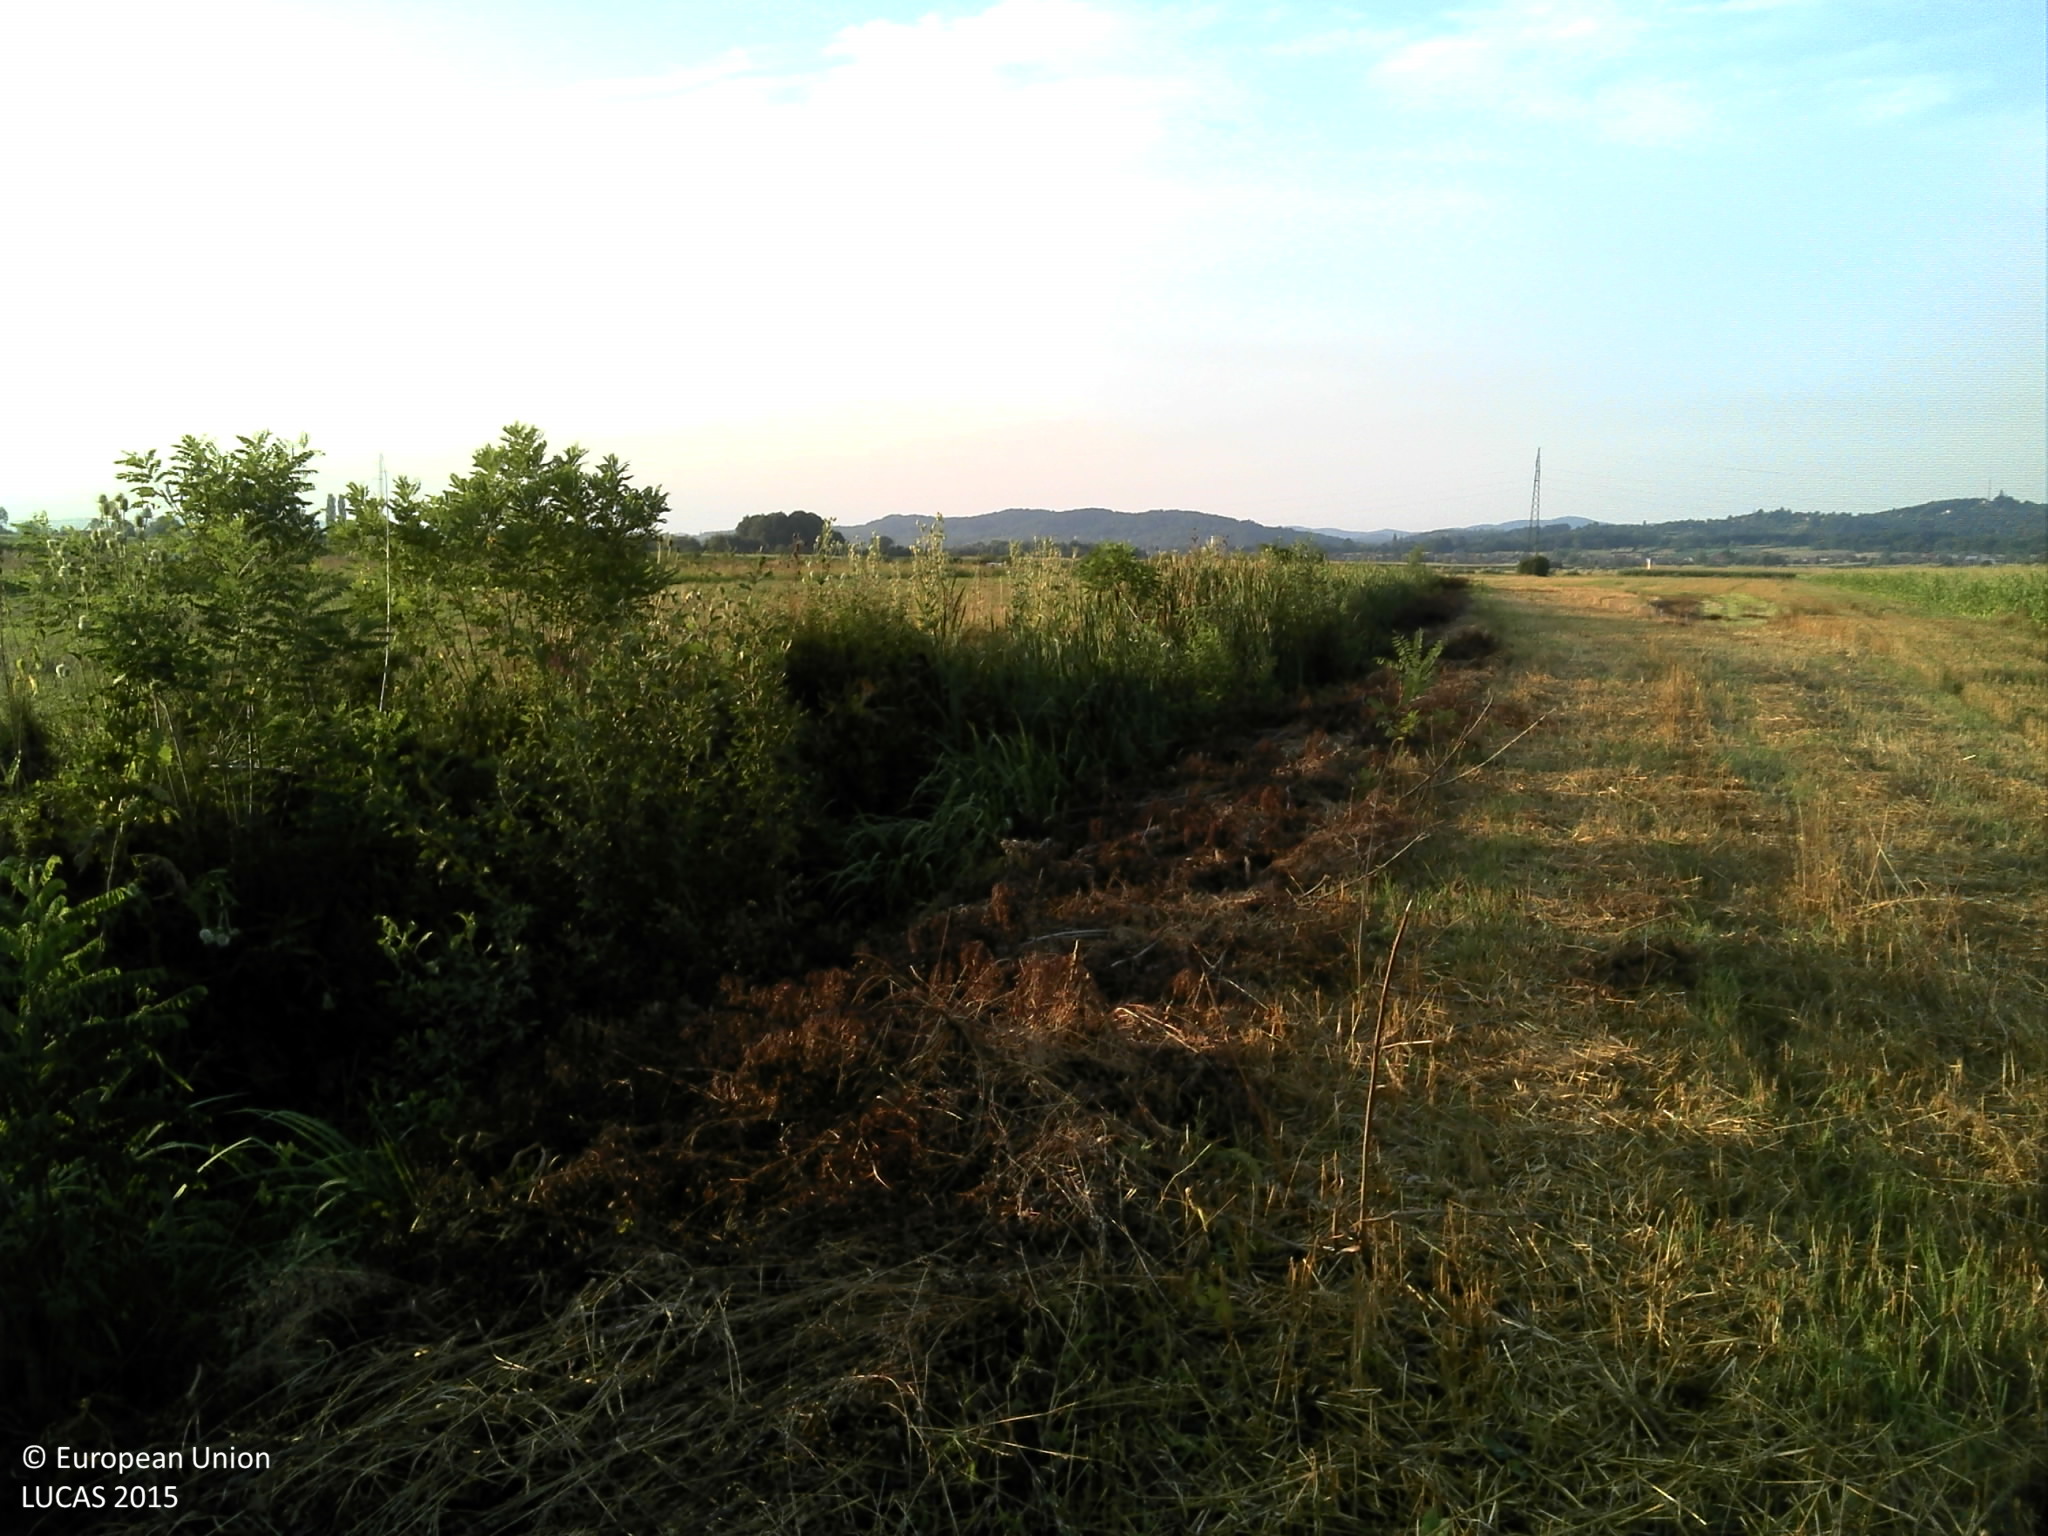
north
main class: Cropland
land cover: Barley
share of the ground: < 10 %
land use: Agriculture (excluding fallow land and kitchen gardens)
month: July
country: HR
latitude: 45.4909
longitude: 16.6908
